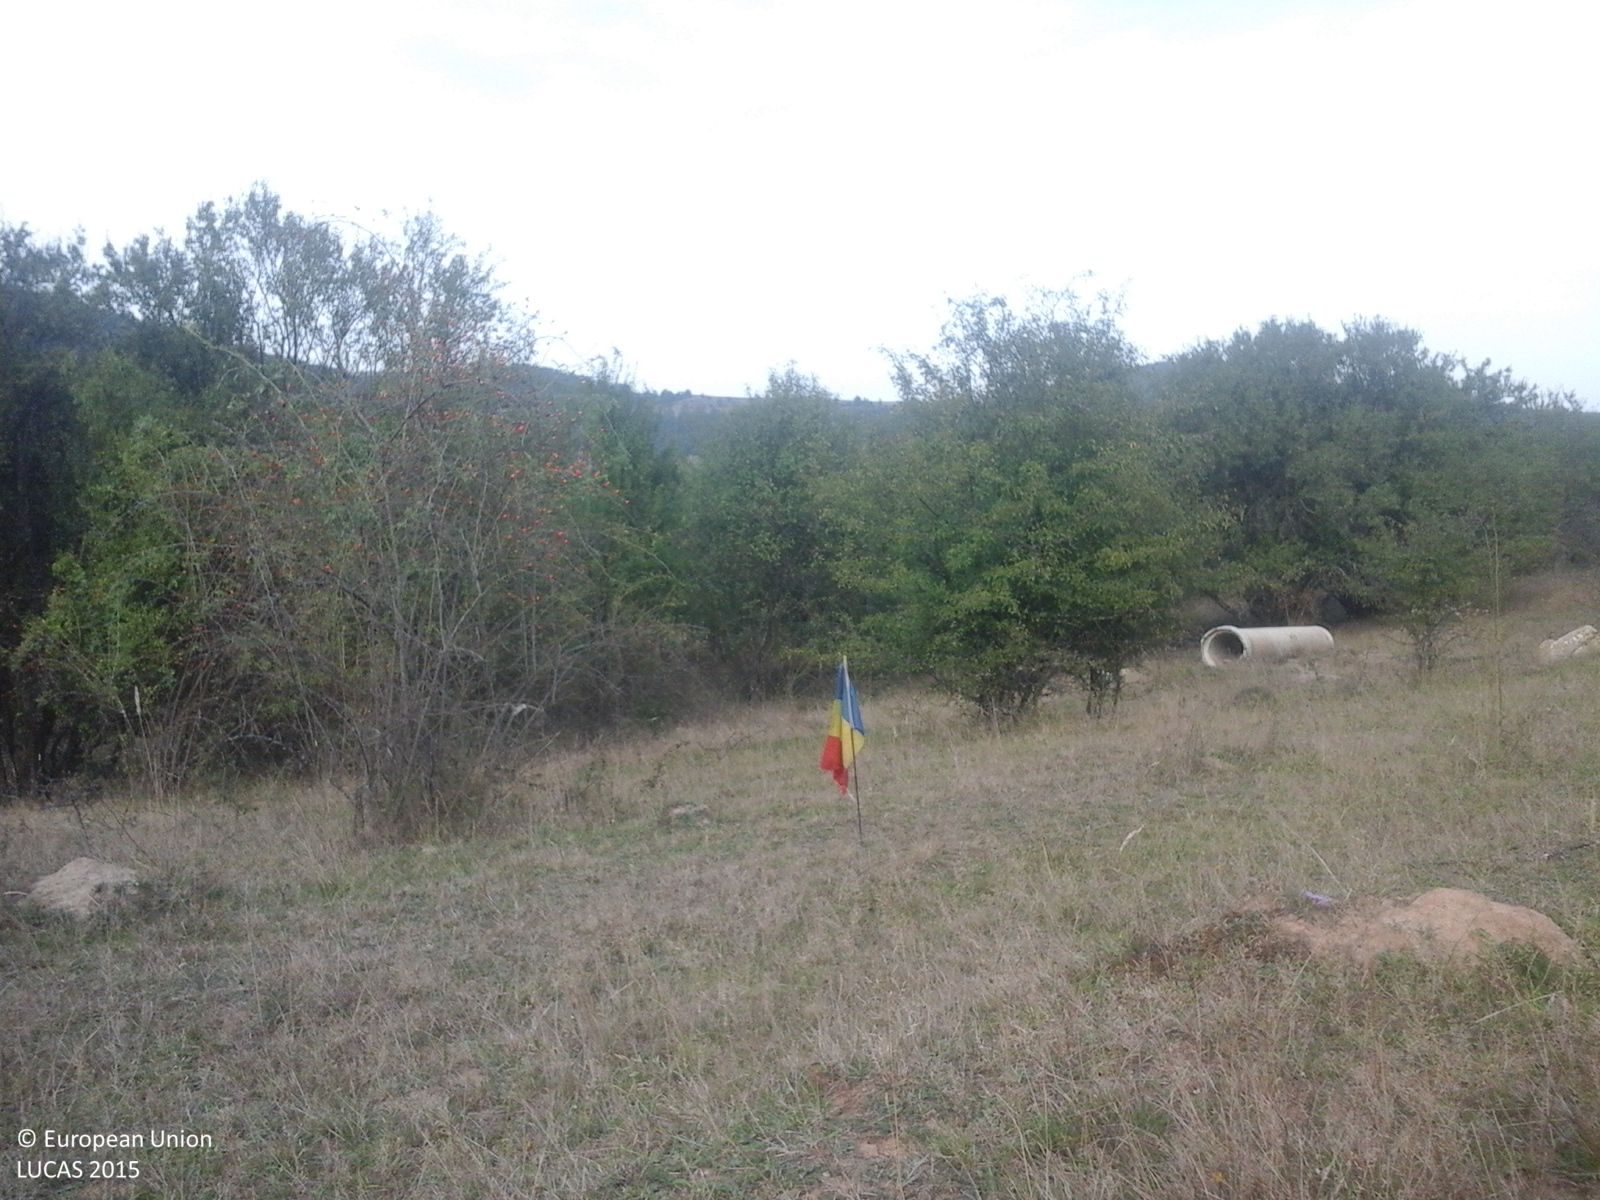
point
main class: Cropland
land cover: Other fruit trees and berries
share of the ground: > 75 %
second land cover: Grassland without tree/shrub cover
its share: > 75 %
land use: Agriculture (excluding fallow land and kitchen gardens)
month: September
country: RO
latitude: 47.0200
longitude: 23.2355
